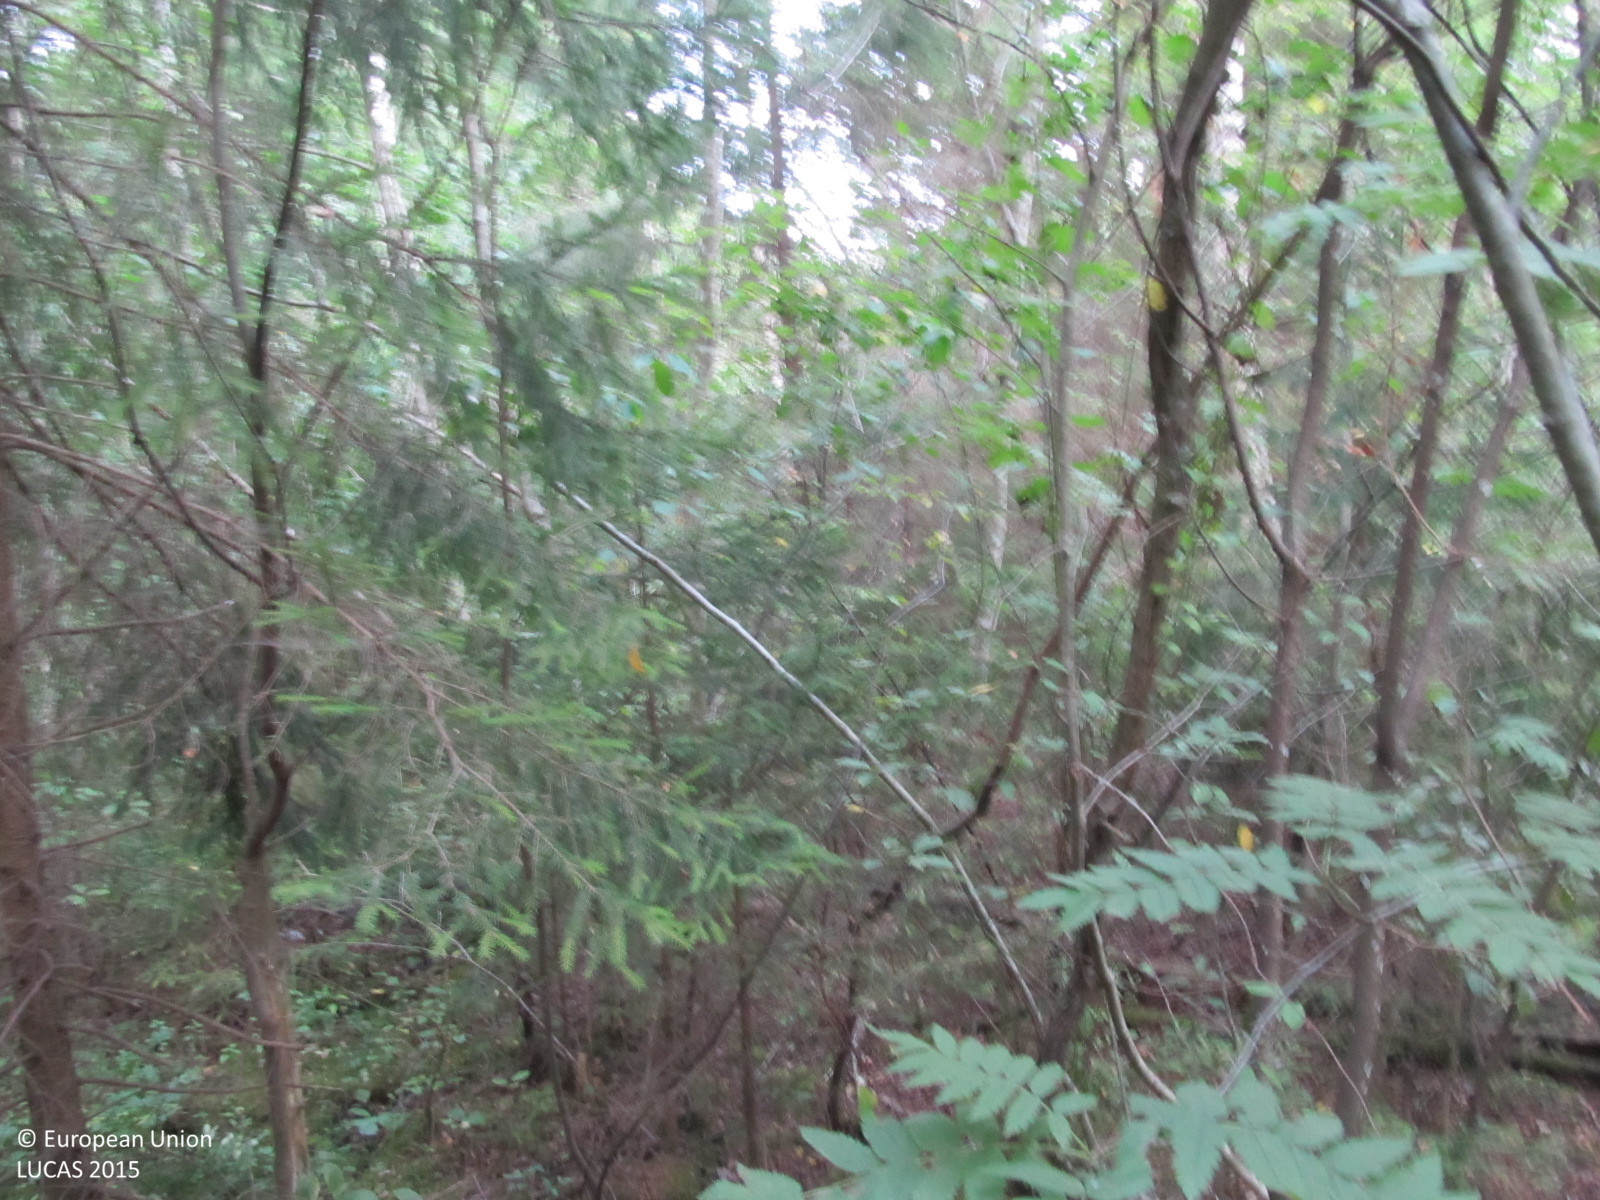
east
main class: Woodland
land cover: Other mixed woodland
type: hemiboreal forest and nemoral coniferous forest and mixed broadleaved-coniferous forest
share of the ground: > 75 %
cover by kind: coniferous forest trees 50 %, broadleaved forest trees 30 %, herbaceous plants 15 %, shrubs 5 %
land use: Forestry
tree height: > 5 m
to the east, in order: Other mixed woodland; Ditches and canals; Other mixed woodland; Paved roads, cycling and walking lanes; Other mixed woodland; Spruce dominated mixed woodland; Artificial constructions in urban areas; Broadleaved woodland
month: August
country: LT
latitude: 55.8566
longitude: 23.1226
